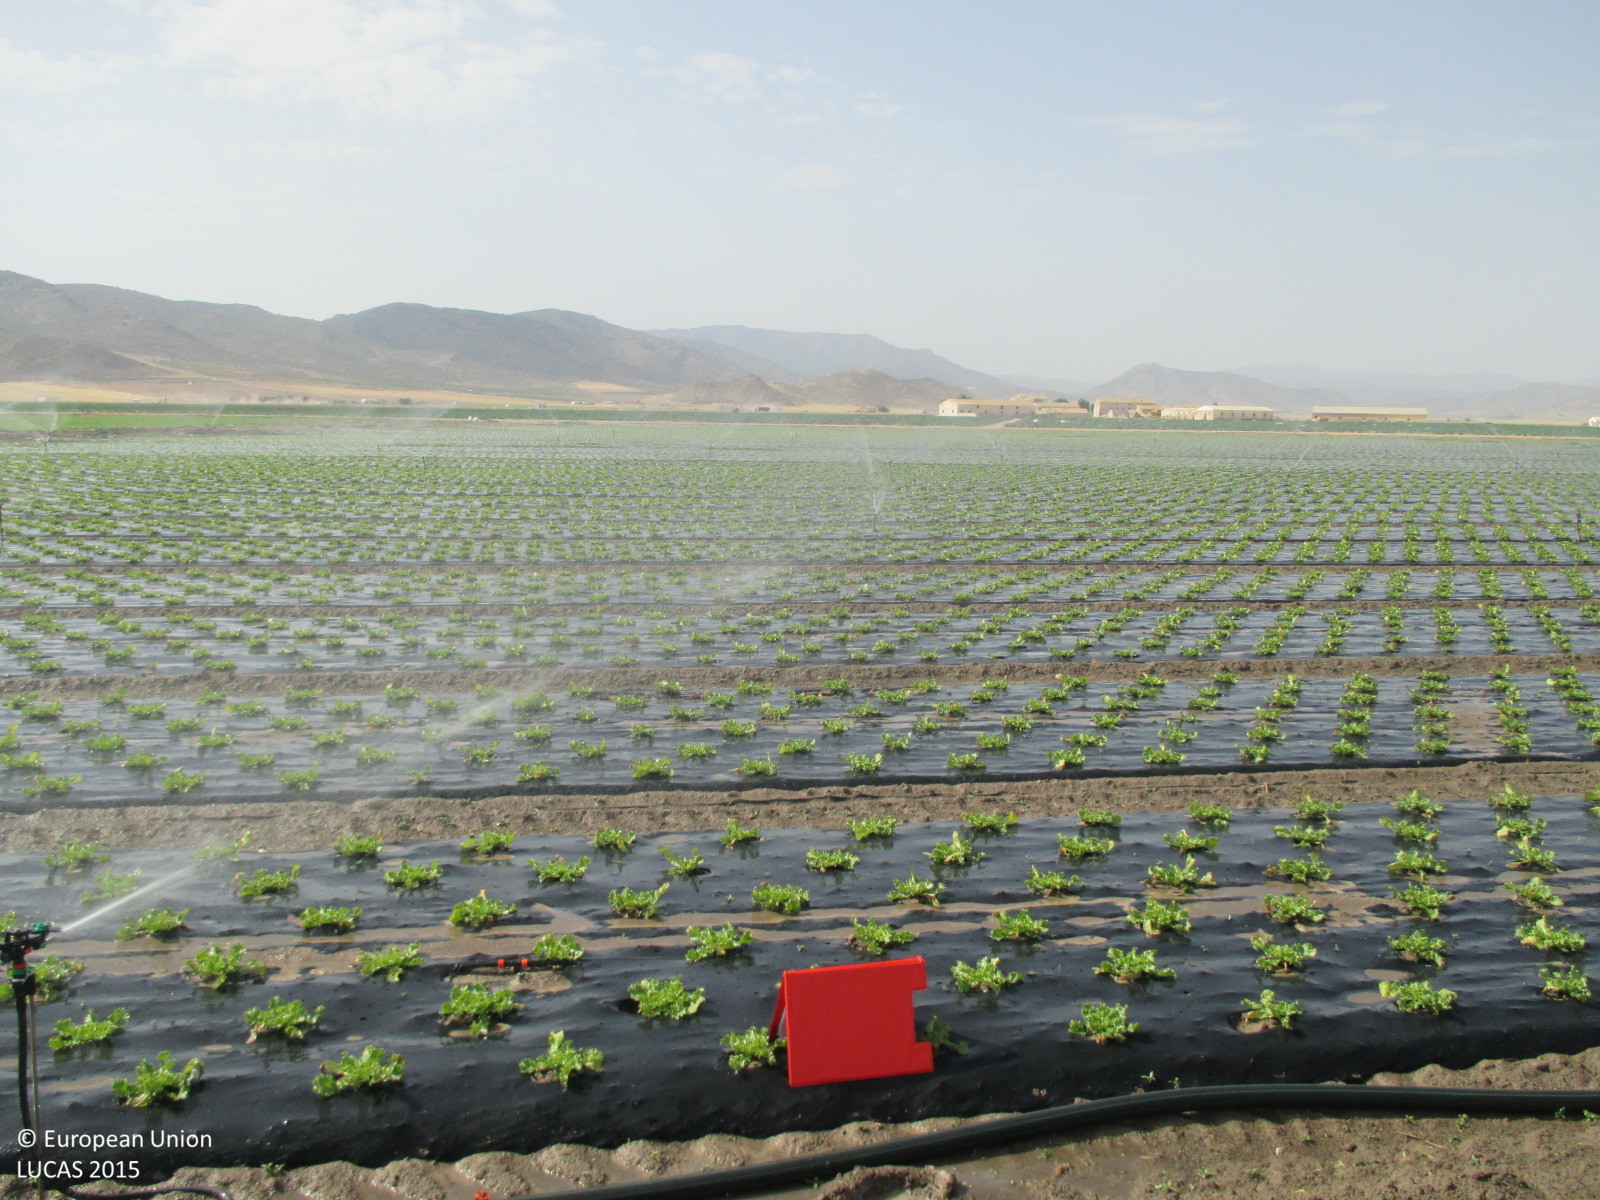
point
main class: Cropland
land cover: Other fresh vegetables
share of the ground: 10 - 25 %
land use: Agriculture (excluding fallow land and kitchen gardens)
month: July
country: ES
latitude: 37.8265
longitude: -2.4298
